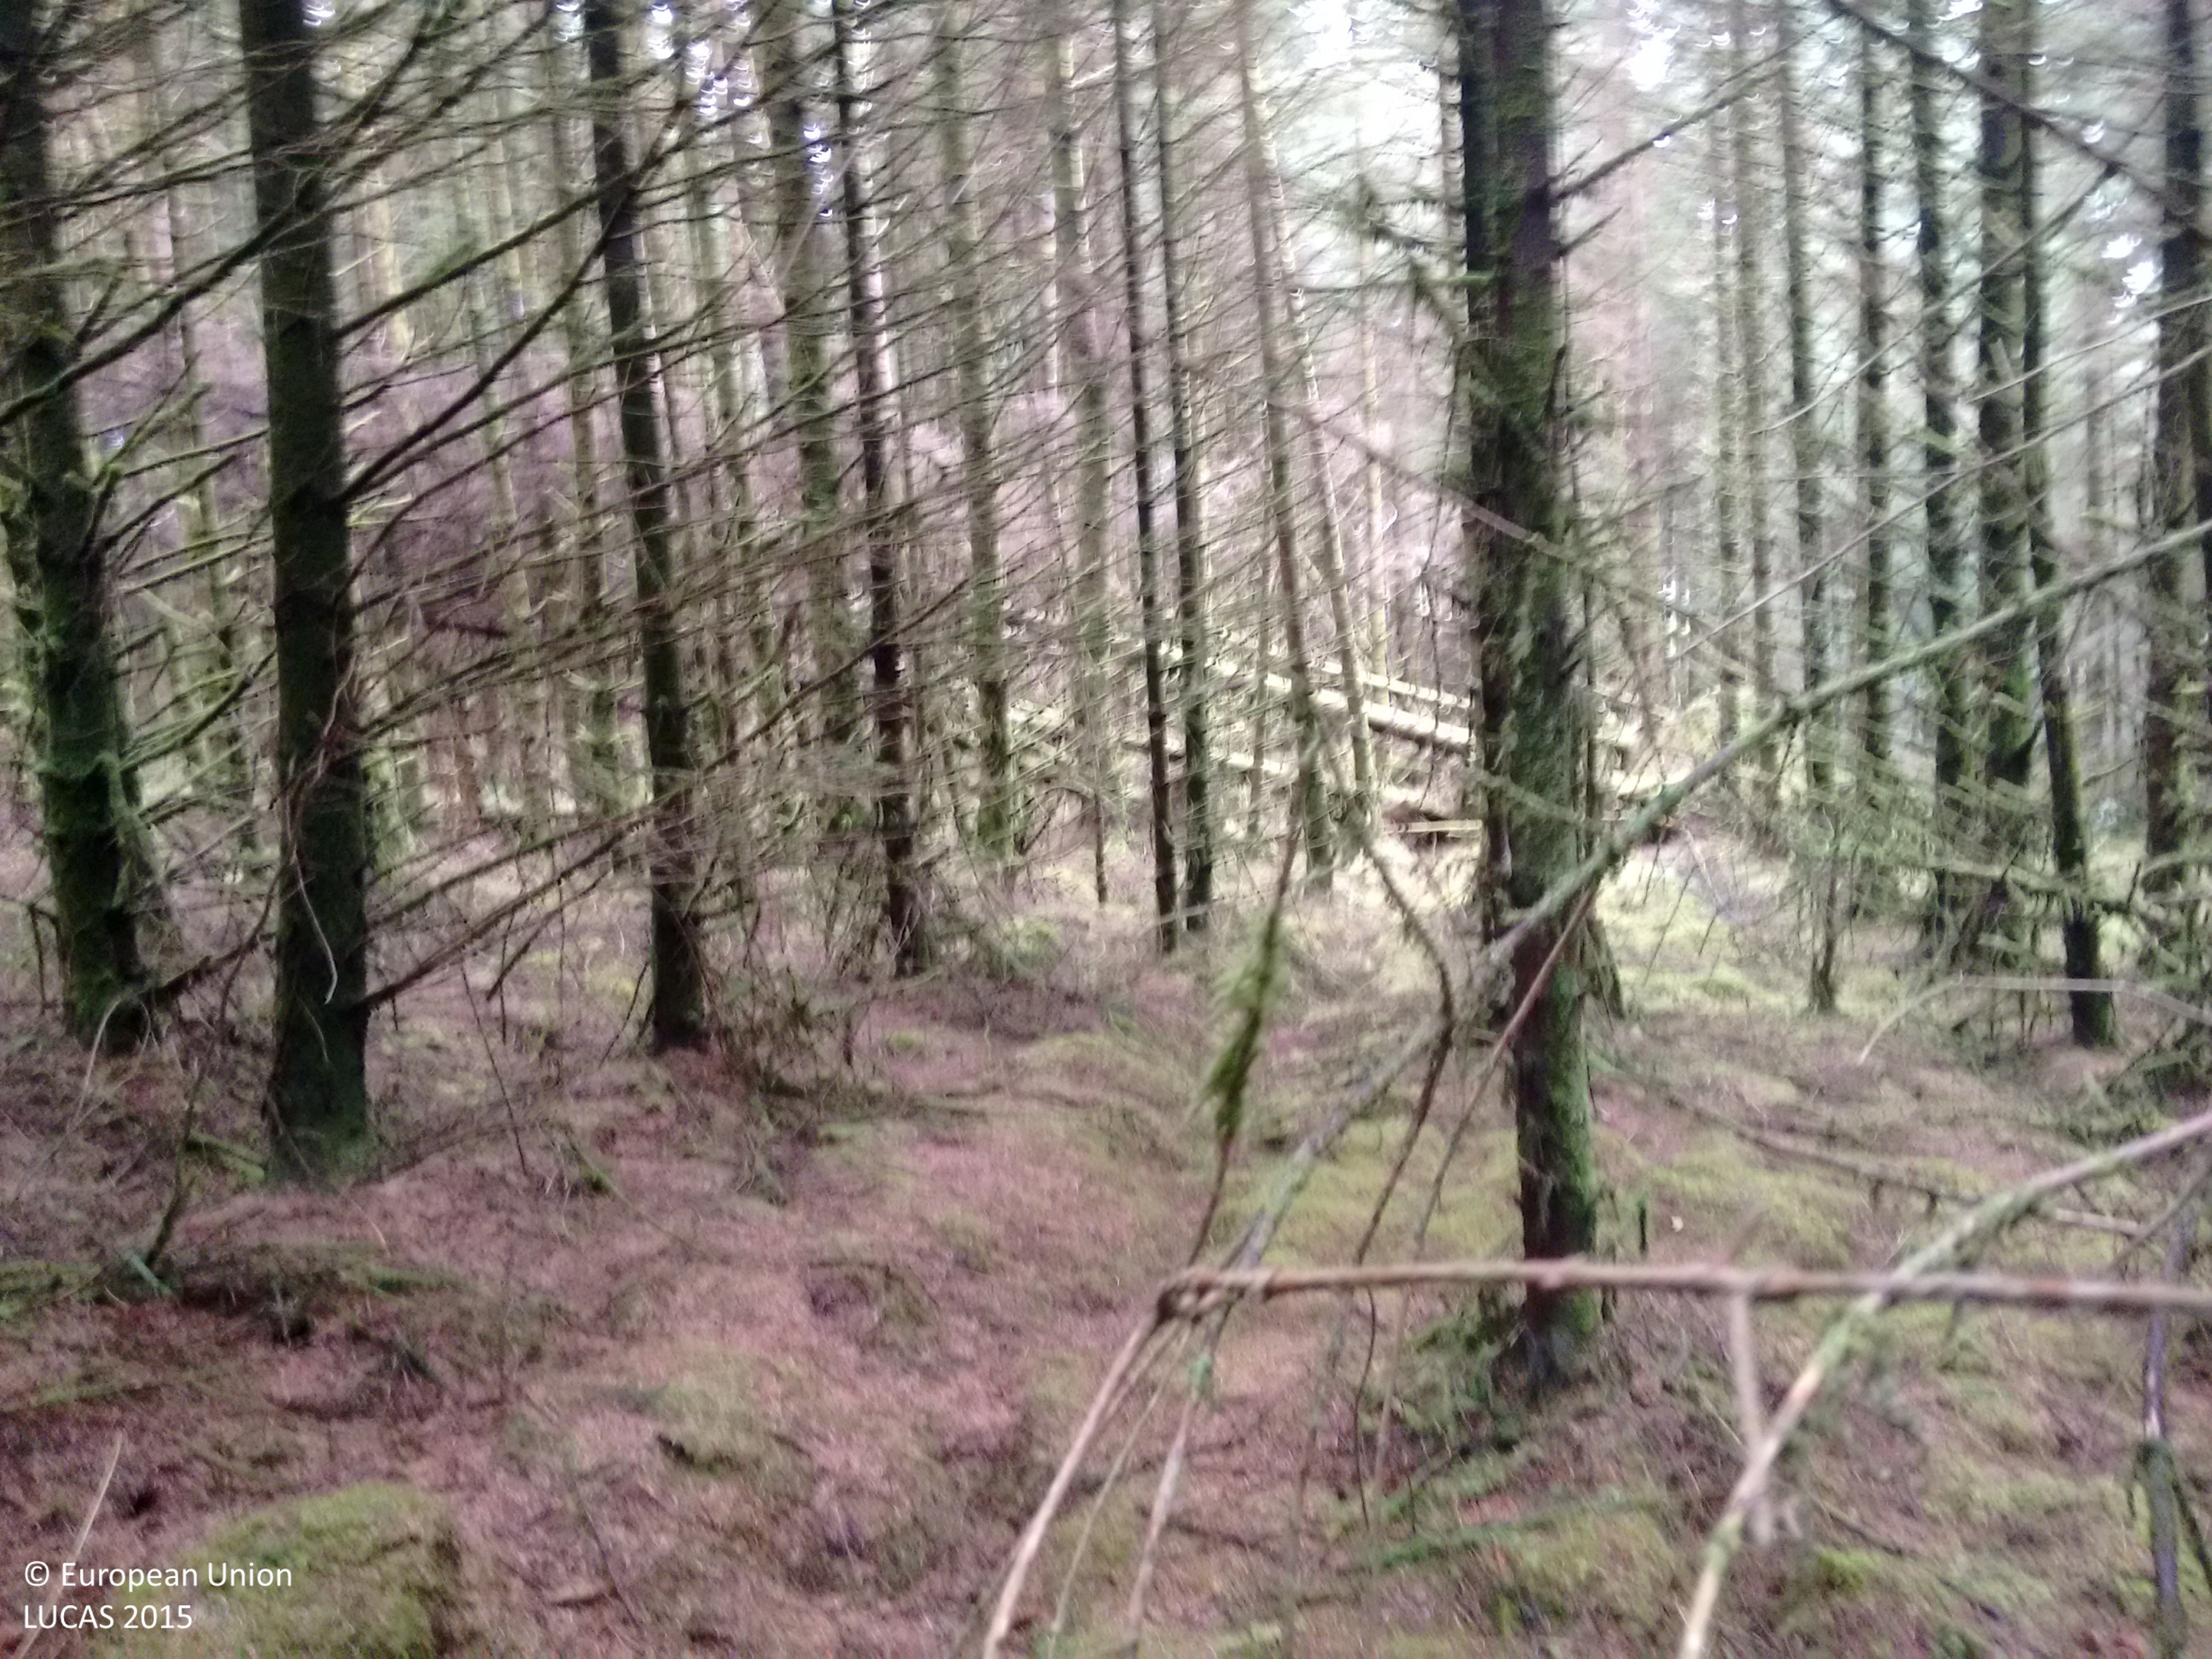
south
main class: Woodland
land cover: Spruce dominated coniferous woodland
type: exotic forest
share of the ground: > 75 %
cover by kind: coniferous forest trees 100 %
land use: Forestry
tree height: > 5 m
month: August
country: IE
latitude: 51.9092
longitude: -10.0093
